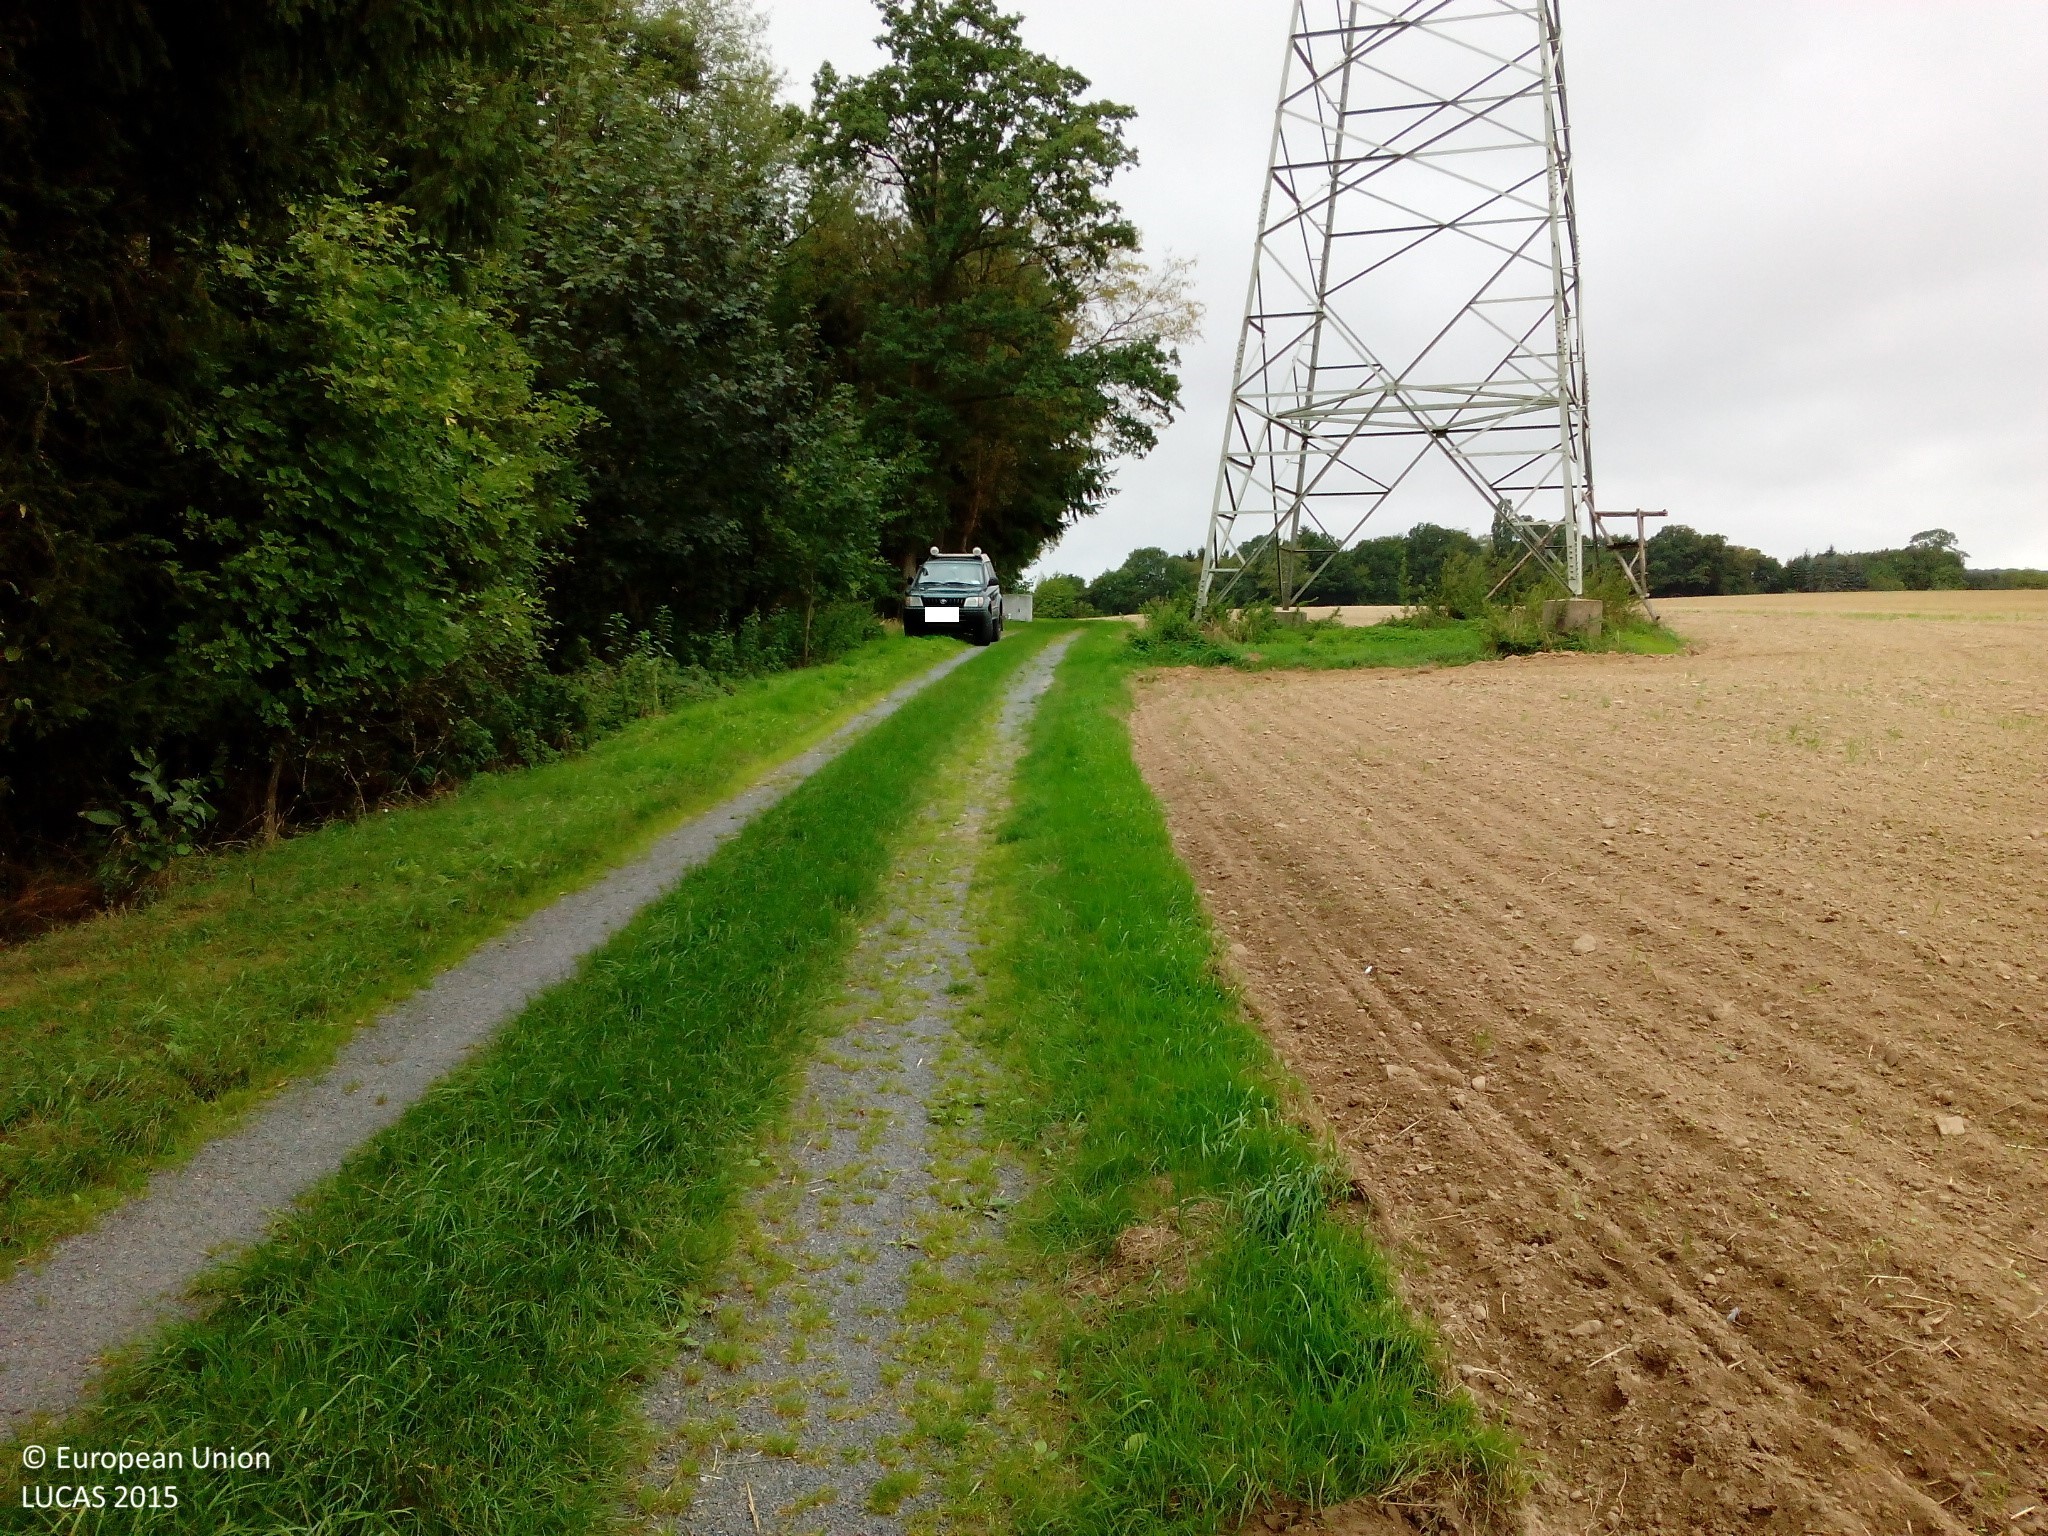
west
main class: Cropland
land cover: Common wheat
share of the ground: < 10 %
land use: Agriculture (excluding fallow land and kitchen gardens)
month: September
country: DE
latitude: 49.8237
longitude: 9.5692
